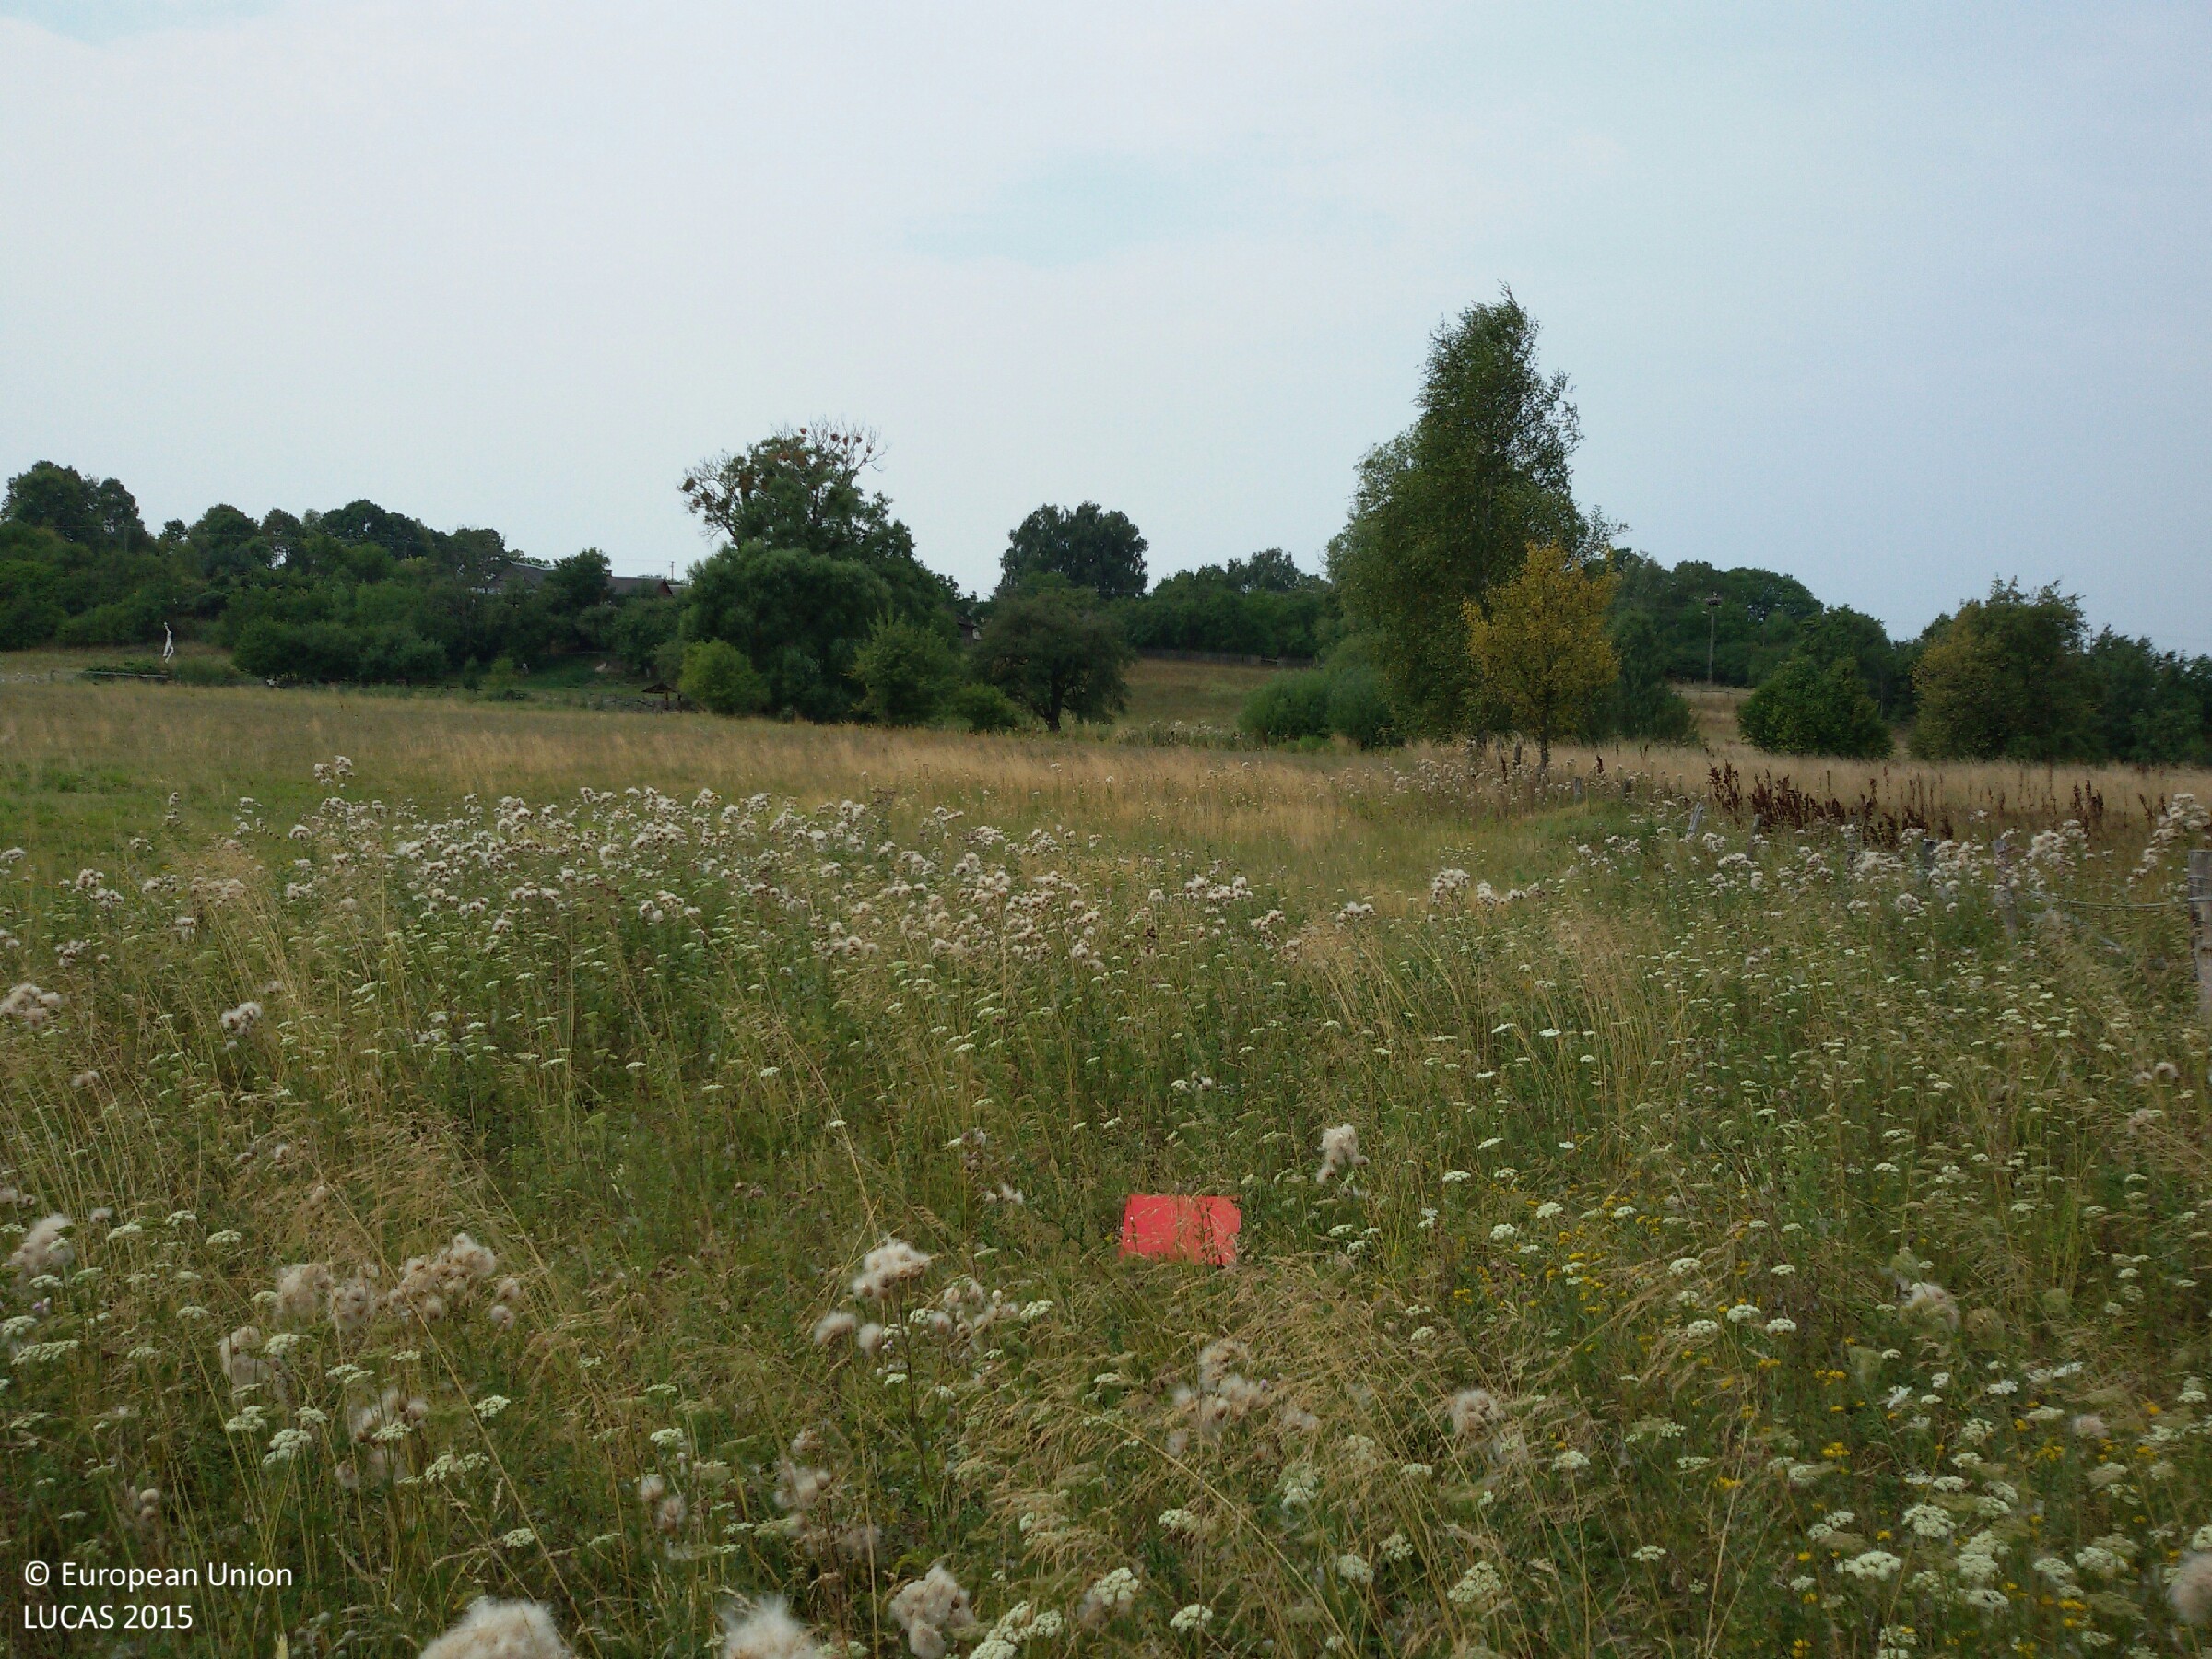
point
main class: Grassland
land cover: Spontaneously vegetated surfaces
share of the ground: > 75 %
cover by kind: herbaceous plants 100 %
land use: Fallow land
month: August
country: PL
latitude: 51.6339
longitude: 23.5363
